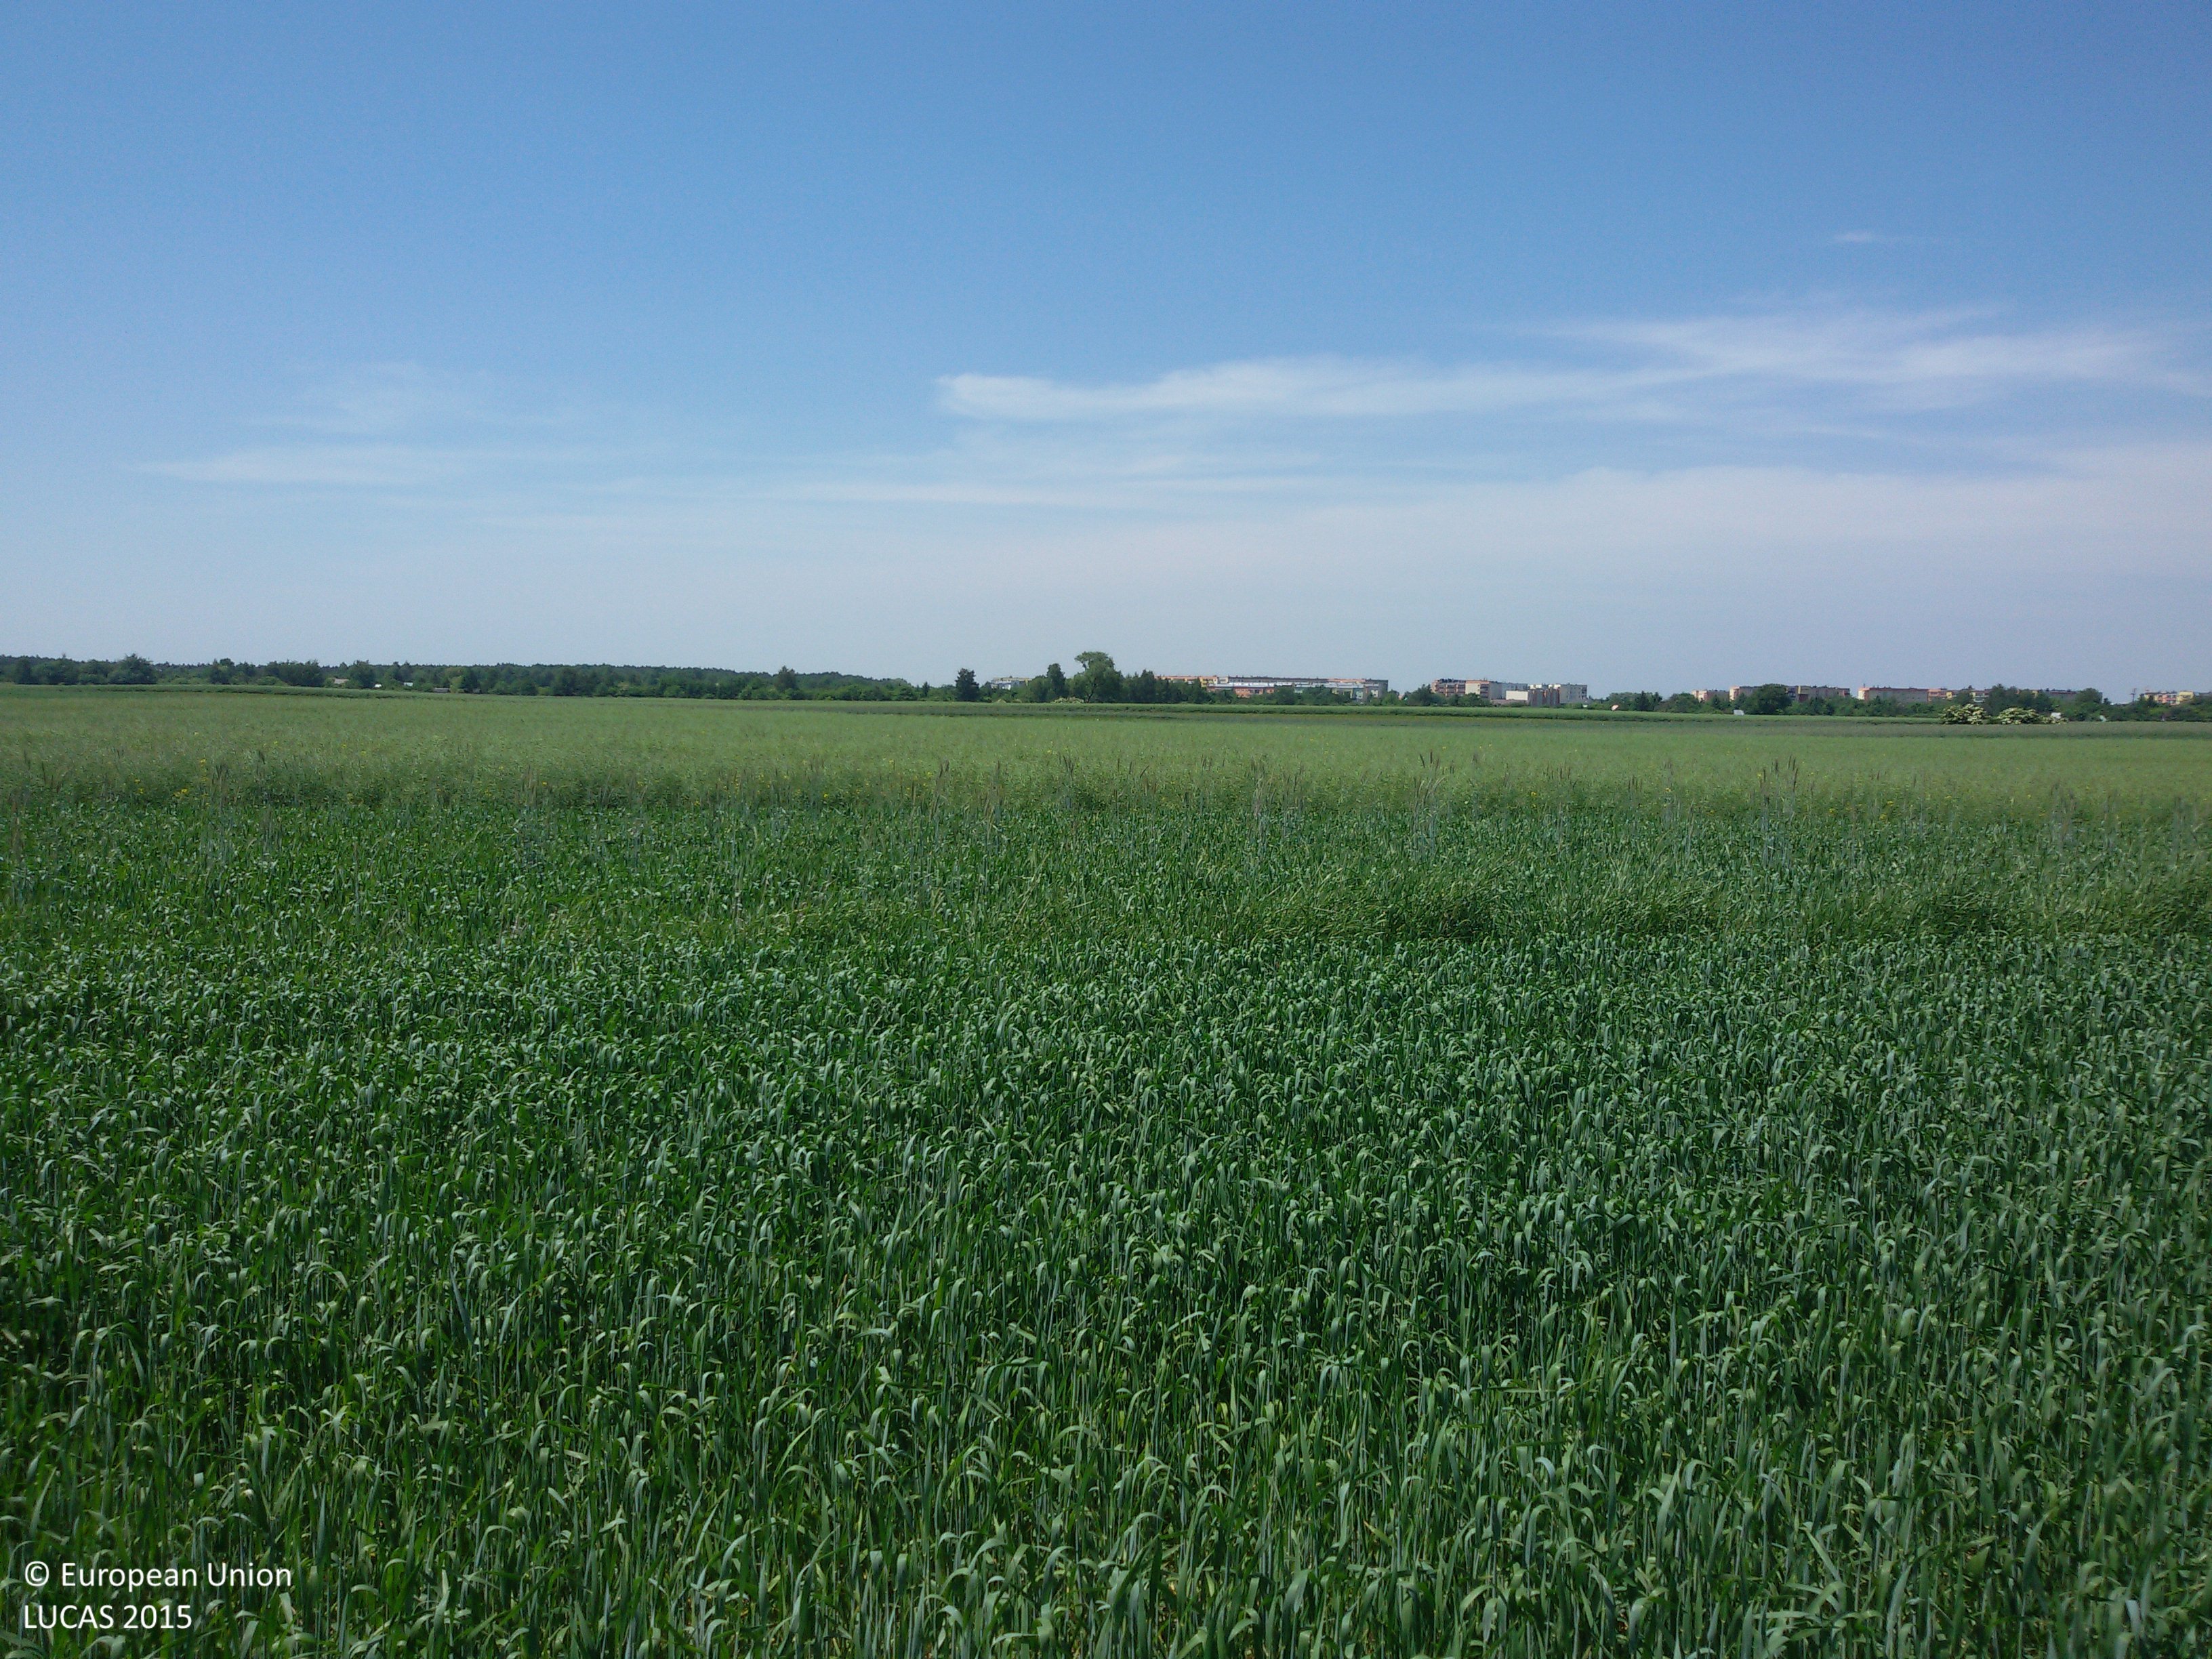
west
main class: Cropland
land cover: Common wheat
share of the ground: > 75 %
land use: Agriculture (excluding fallow land and kitchen gardens)
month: June
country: PL
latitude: 51.2866
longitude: 22.9063
